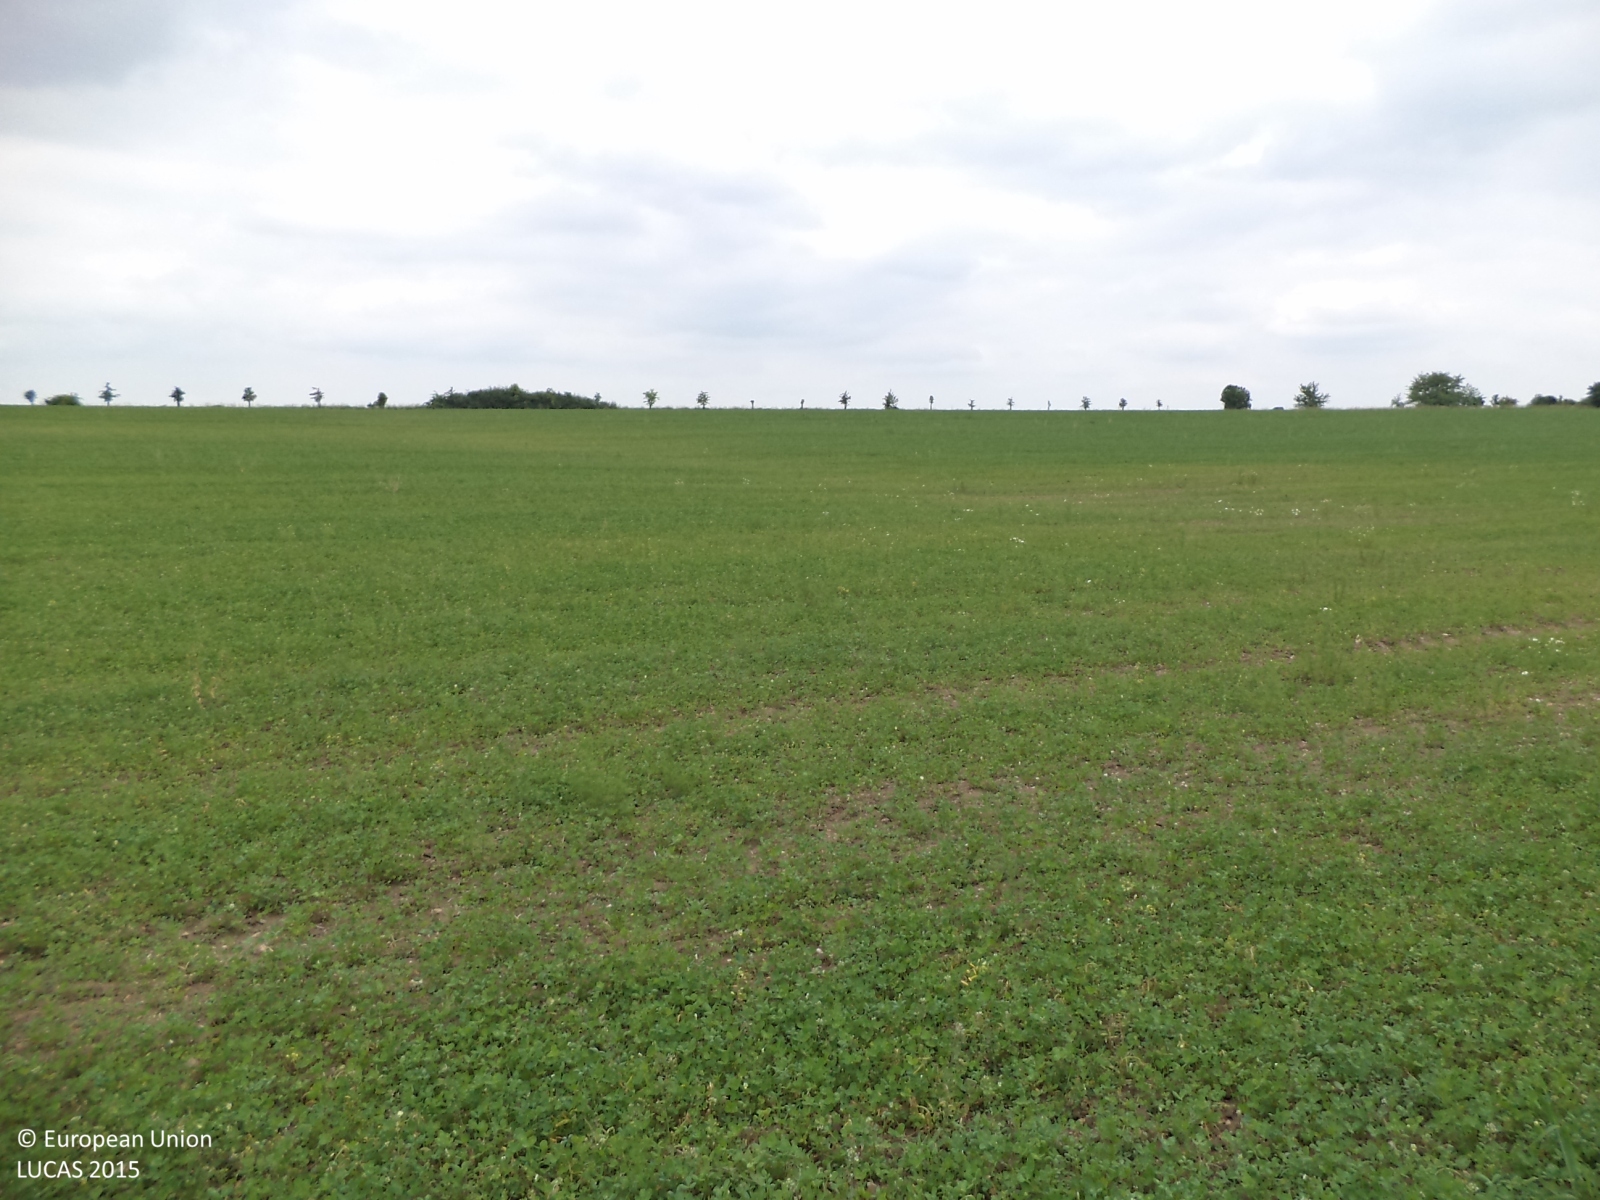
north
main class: Cropland
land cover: Clovers
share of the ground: 50 - 75 %
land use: Agriculture (excluding fallow land and kitchen gardens)
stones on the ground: < 10 %
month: June
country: CZ
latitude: 49.1762
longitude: 14.5143
